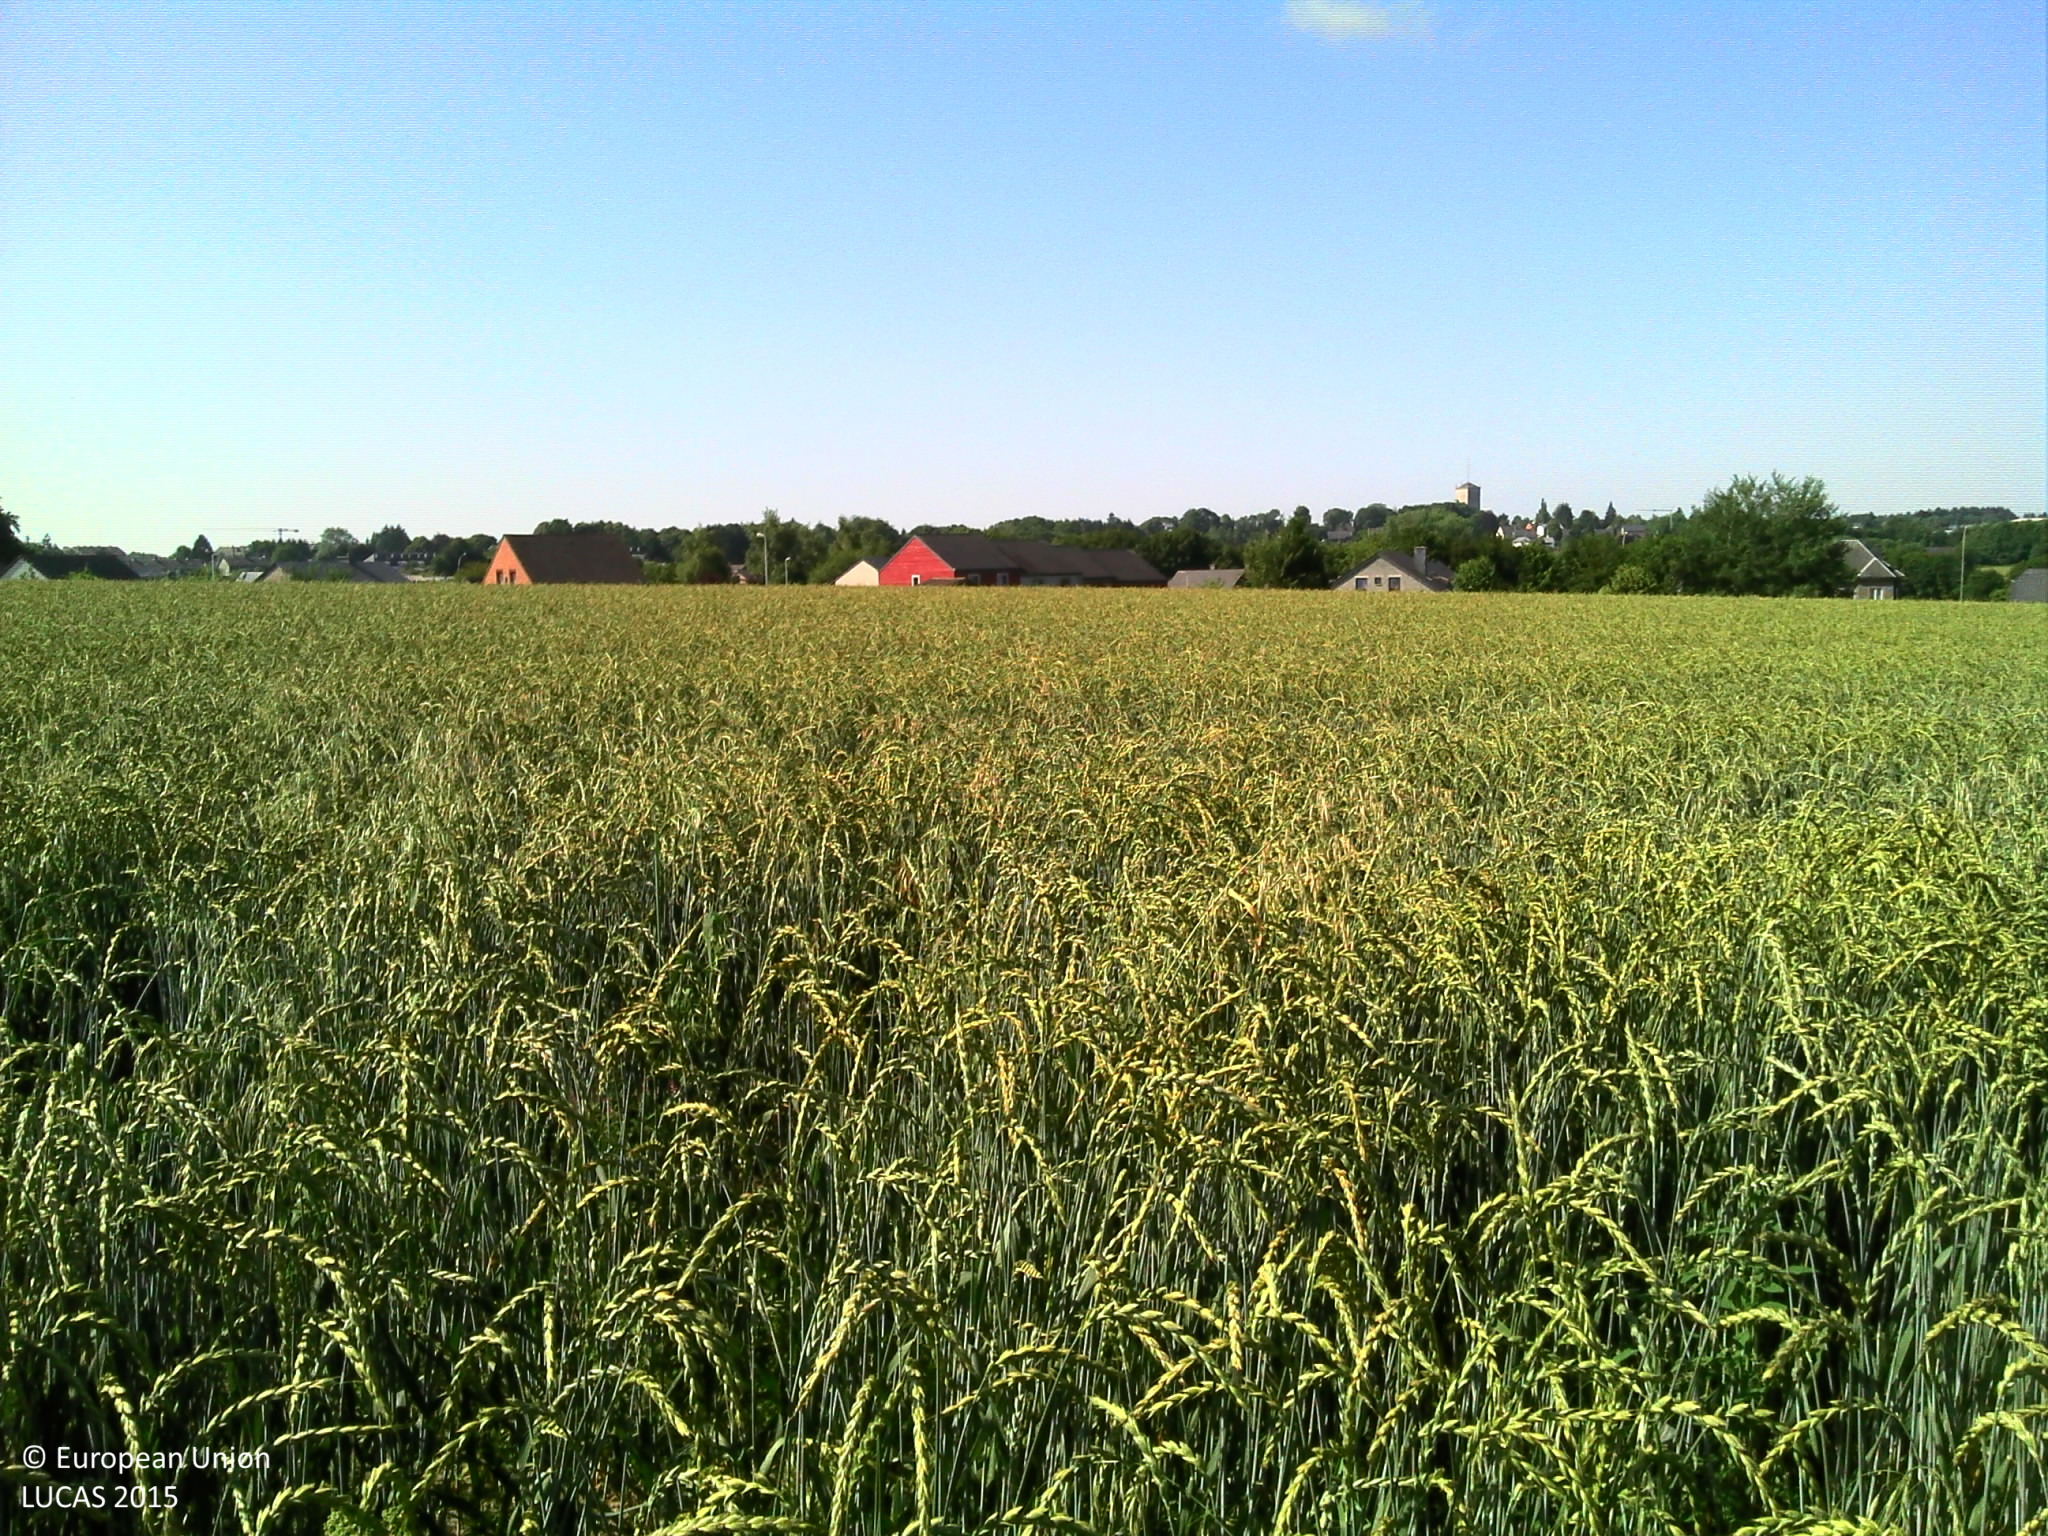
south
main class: Grassland
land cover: Grassland without tree/shrub cover
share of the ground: > 75 %
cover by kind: herbaceous plants 100 %
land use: Agriculture (excluding fallow land and kitchen gardens)
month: July
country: BE
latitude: 50.0137
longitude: 5.7145
